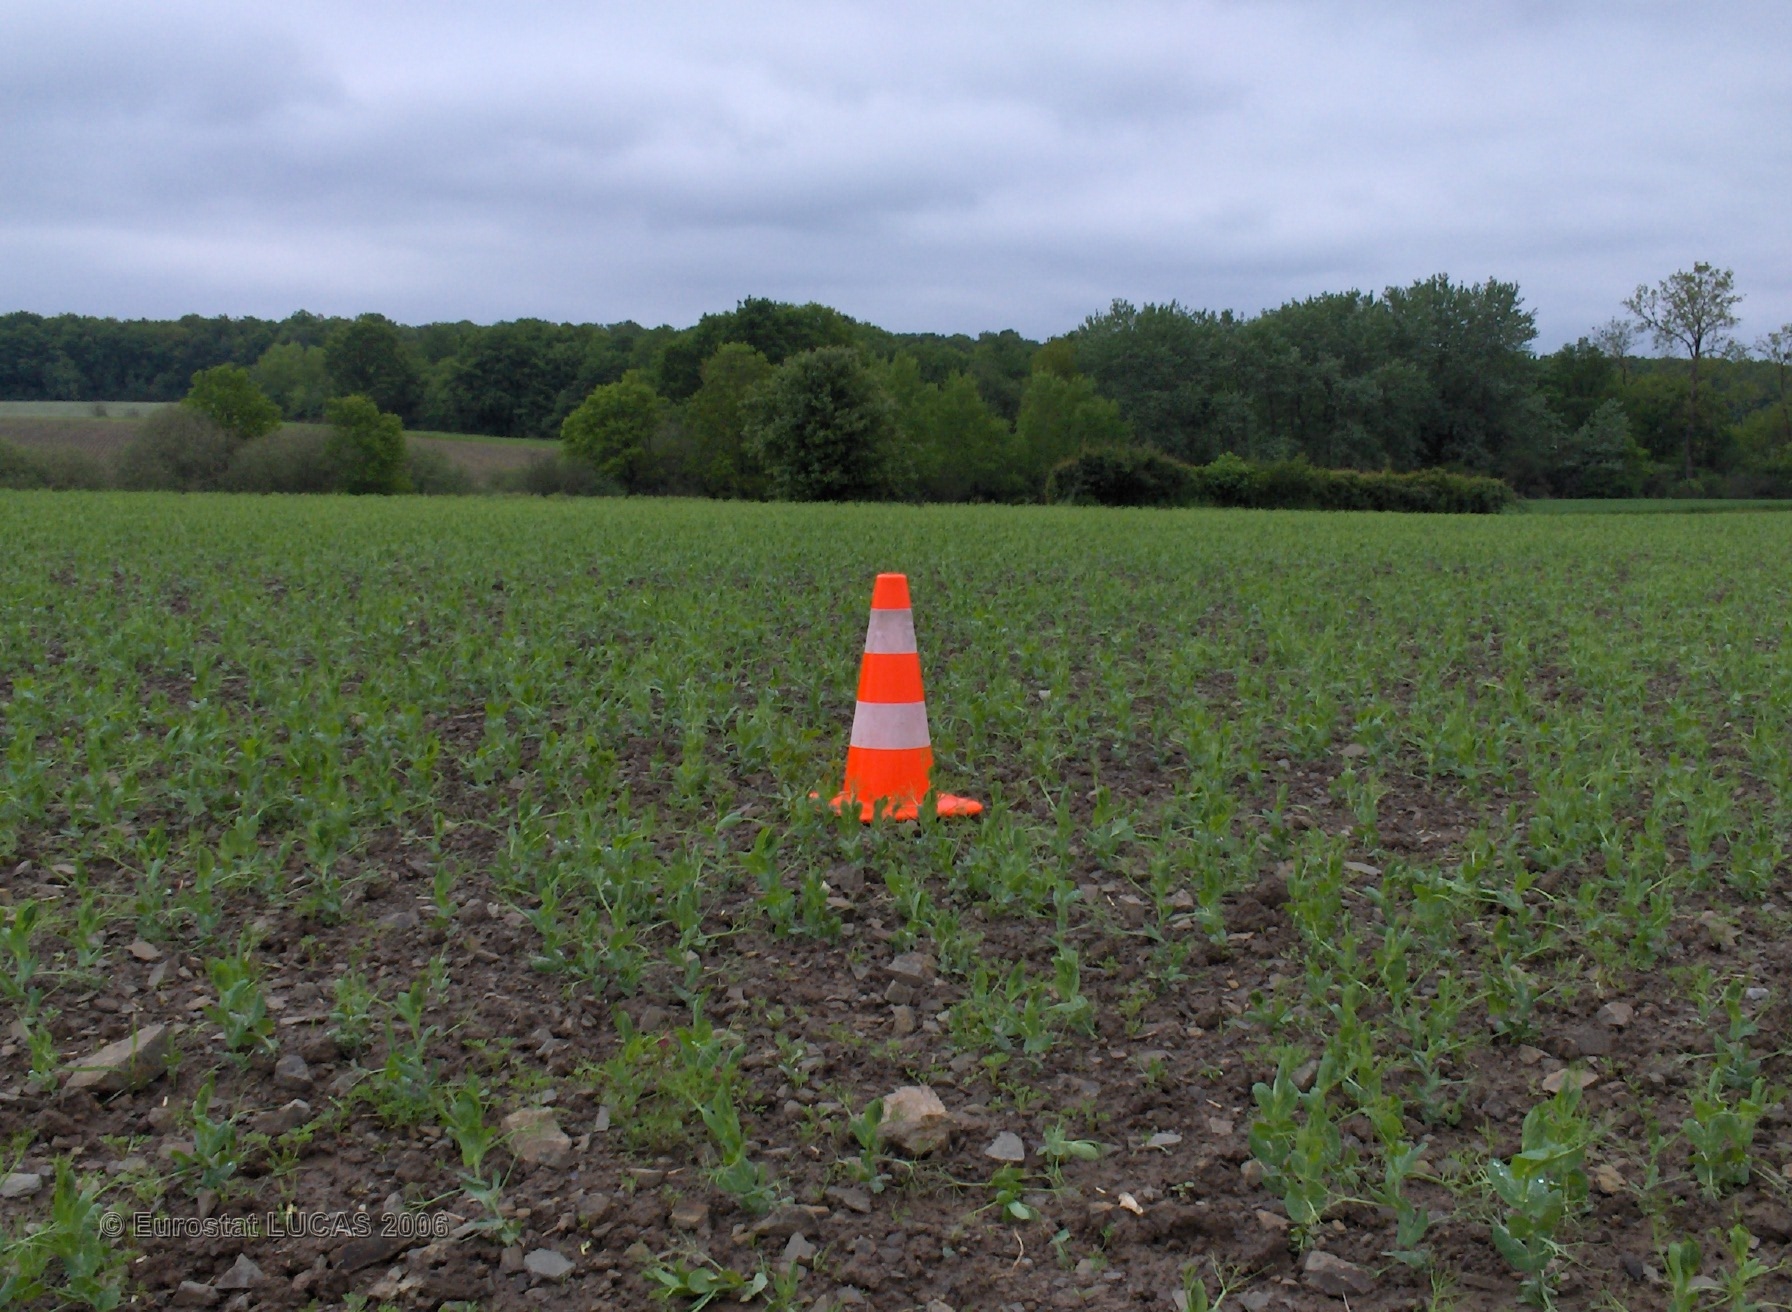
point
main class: Cropland
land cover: Dry pulses
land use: Agriculture (excluding fallow land and kitchen gardens)
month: June
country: BE
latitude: 50.1276
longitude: 4.5827
